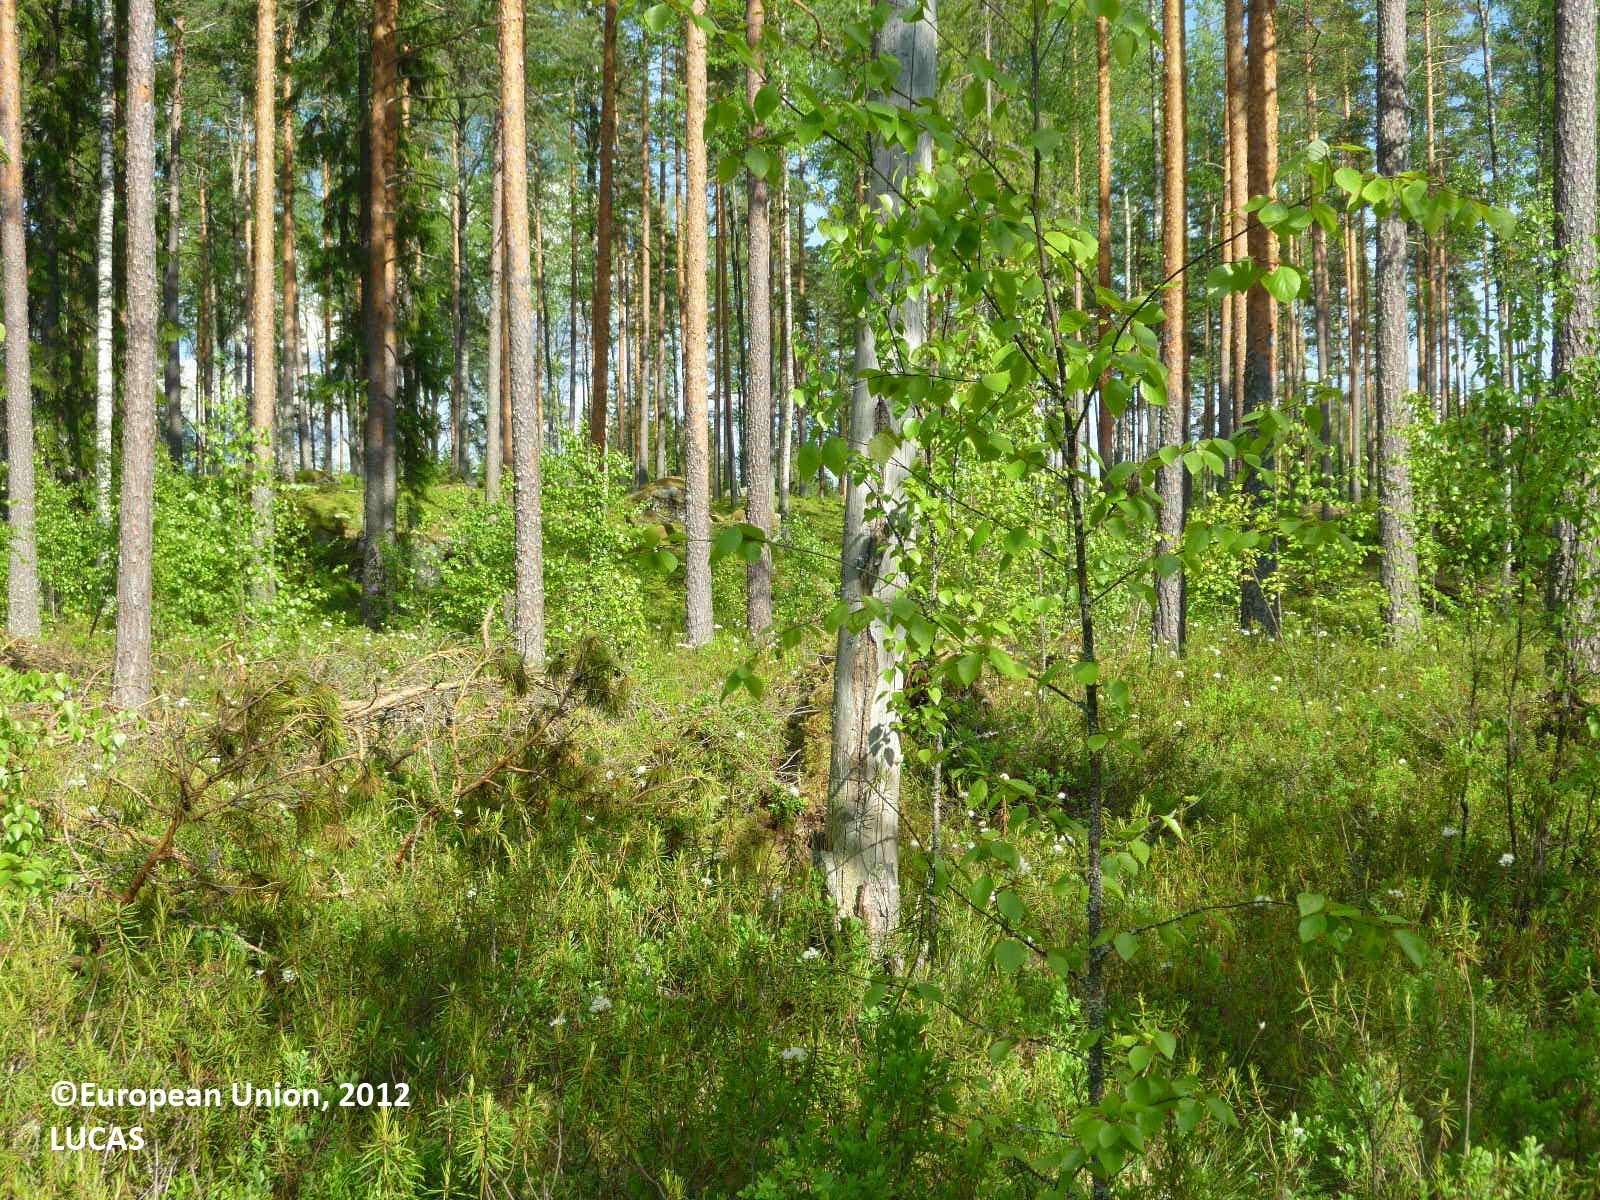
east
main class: Woodland
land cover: Broadleaved woodland
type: boreal forest
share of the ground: > 75 %
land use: Forestry
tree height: > 5 m
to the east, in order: Broadleaved woodland; Pine dominated mixed woodland; Pine dominated coniferous woodland; Ditches and canals; Shrubland without tree cover; Ditches and canals; Spruce dominated coniferous woodland; Ditches and canals; Shrubland without tree cover
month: June
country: FI
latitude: 61.4089
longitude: 22.7494
